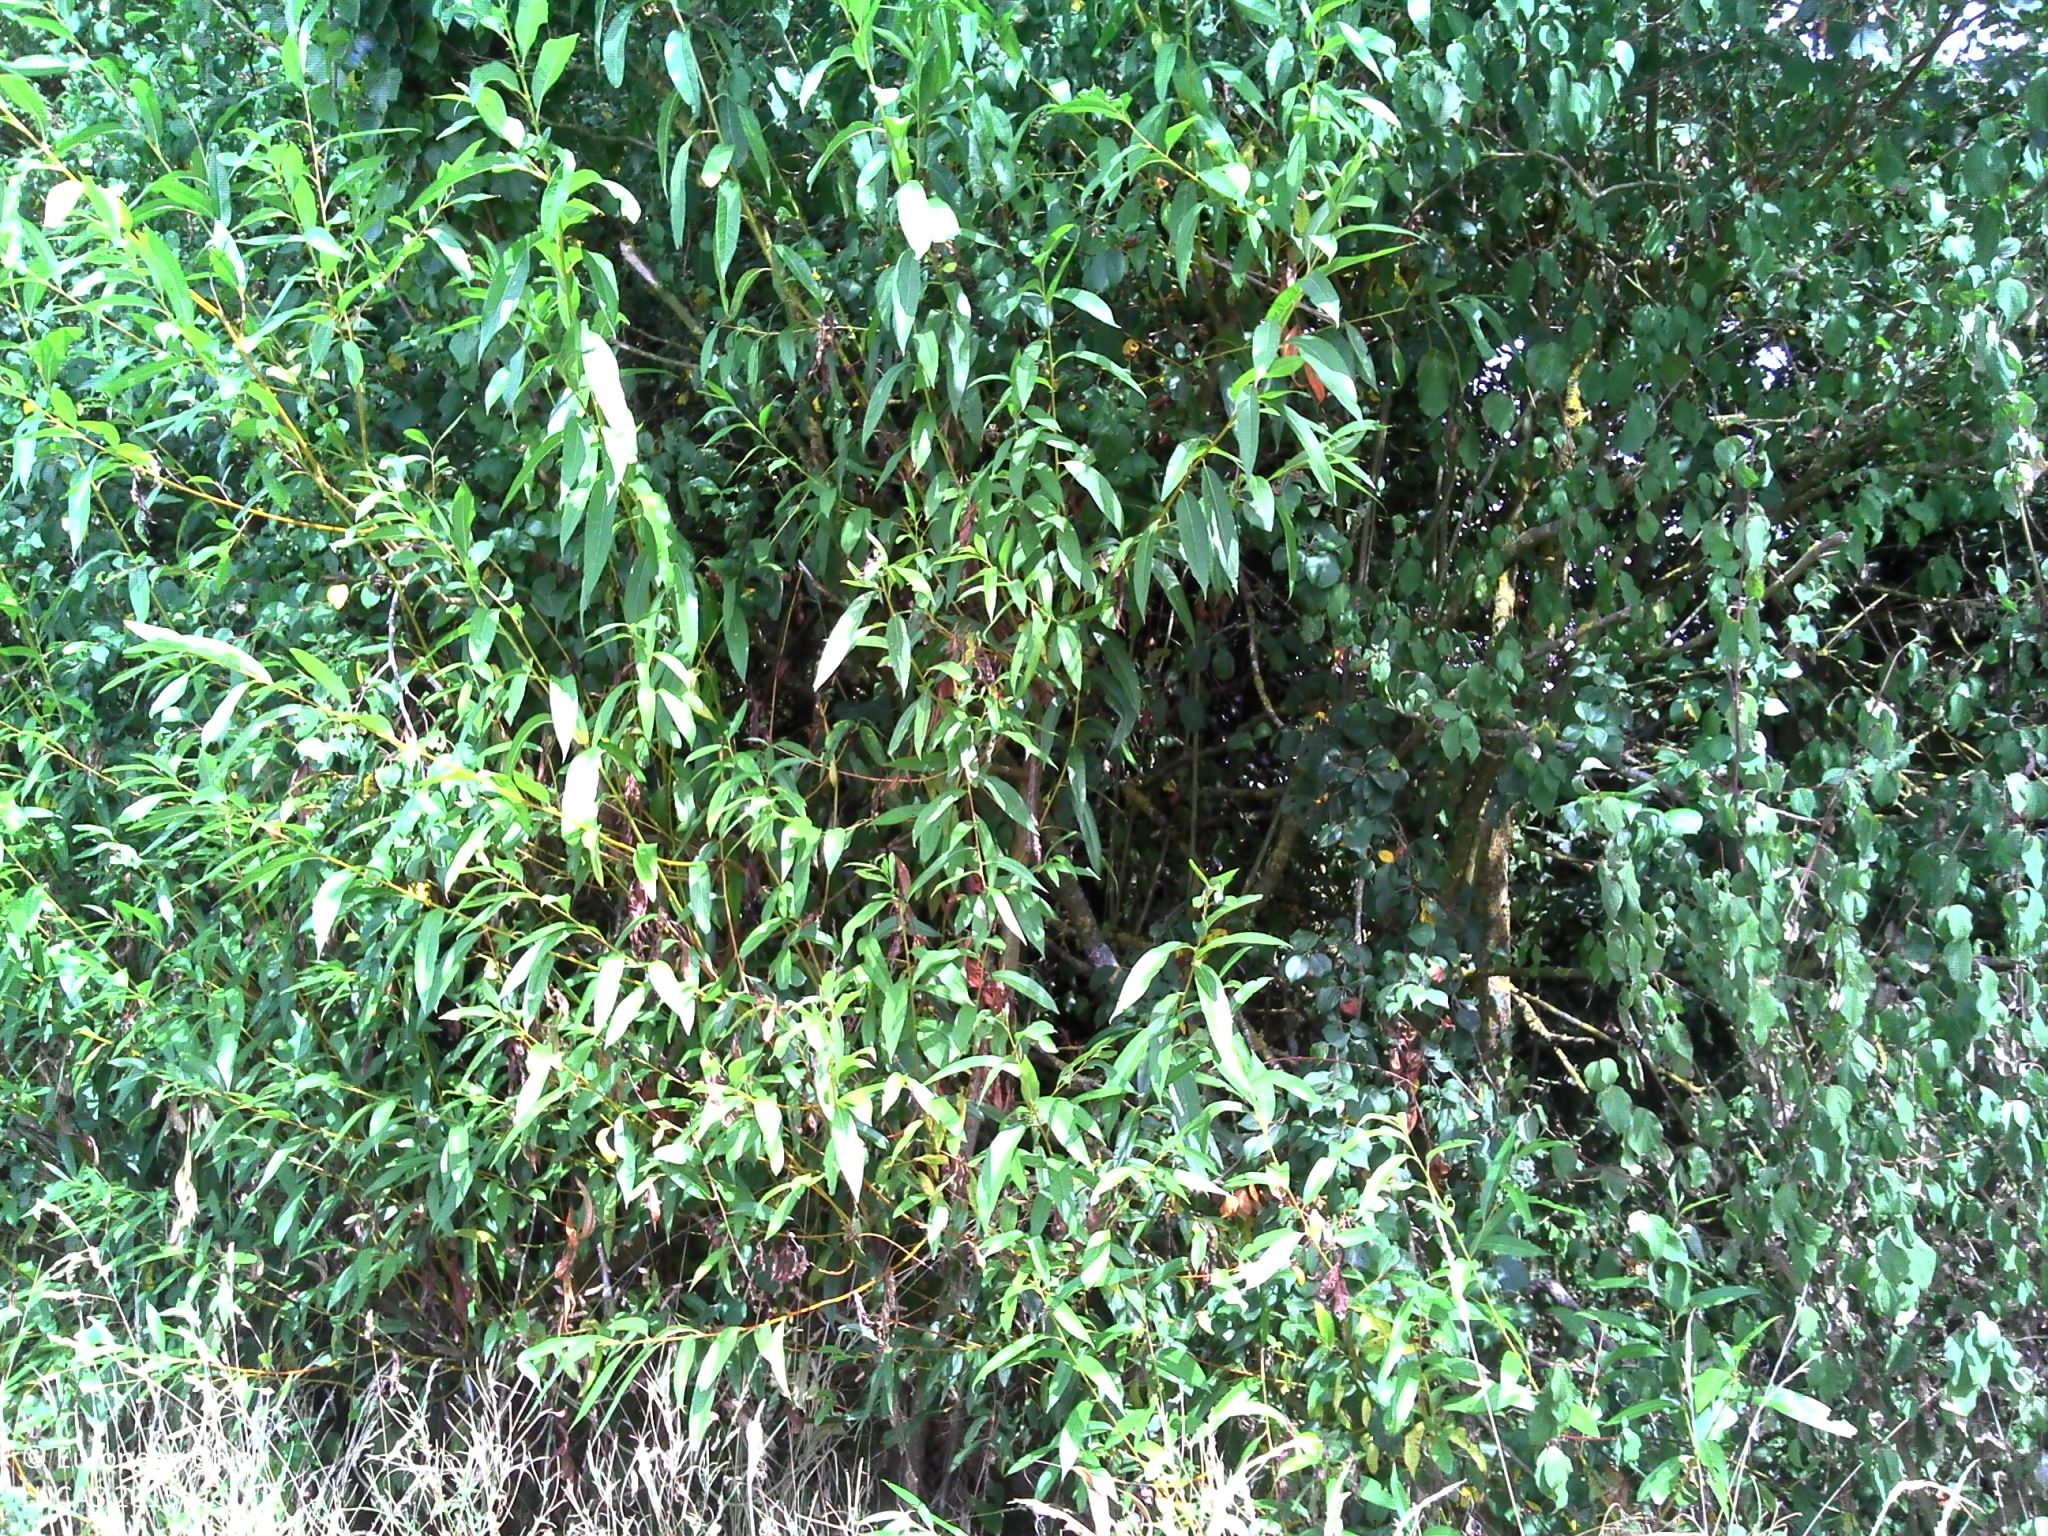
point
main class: Woodland
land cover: Broadleaved woodland
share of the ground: 50 - 75 %
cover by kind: broadleaved forest trees 45 %, herbaceous plants 40 %, shrubs 15 %
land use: Semi-natural and natural areas not in use
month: July
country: FR
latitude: 47.8493
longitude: 0.7179
